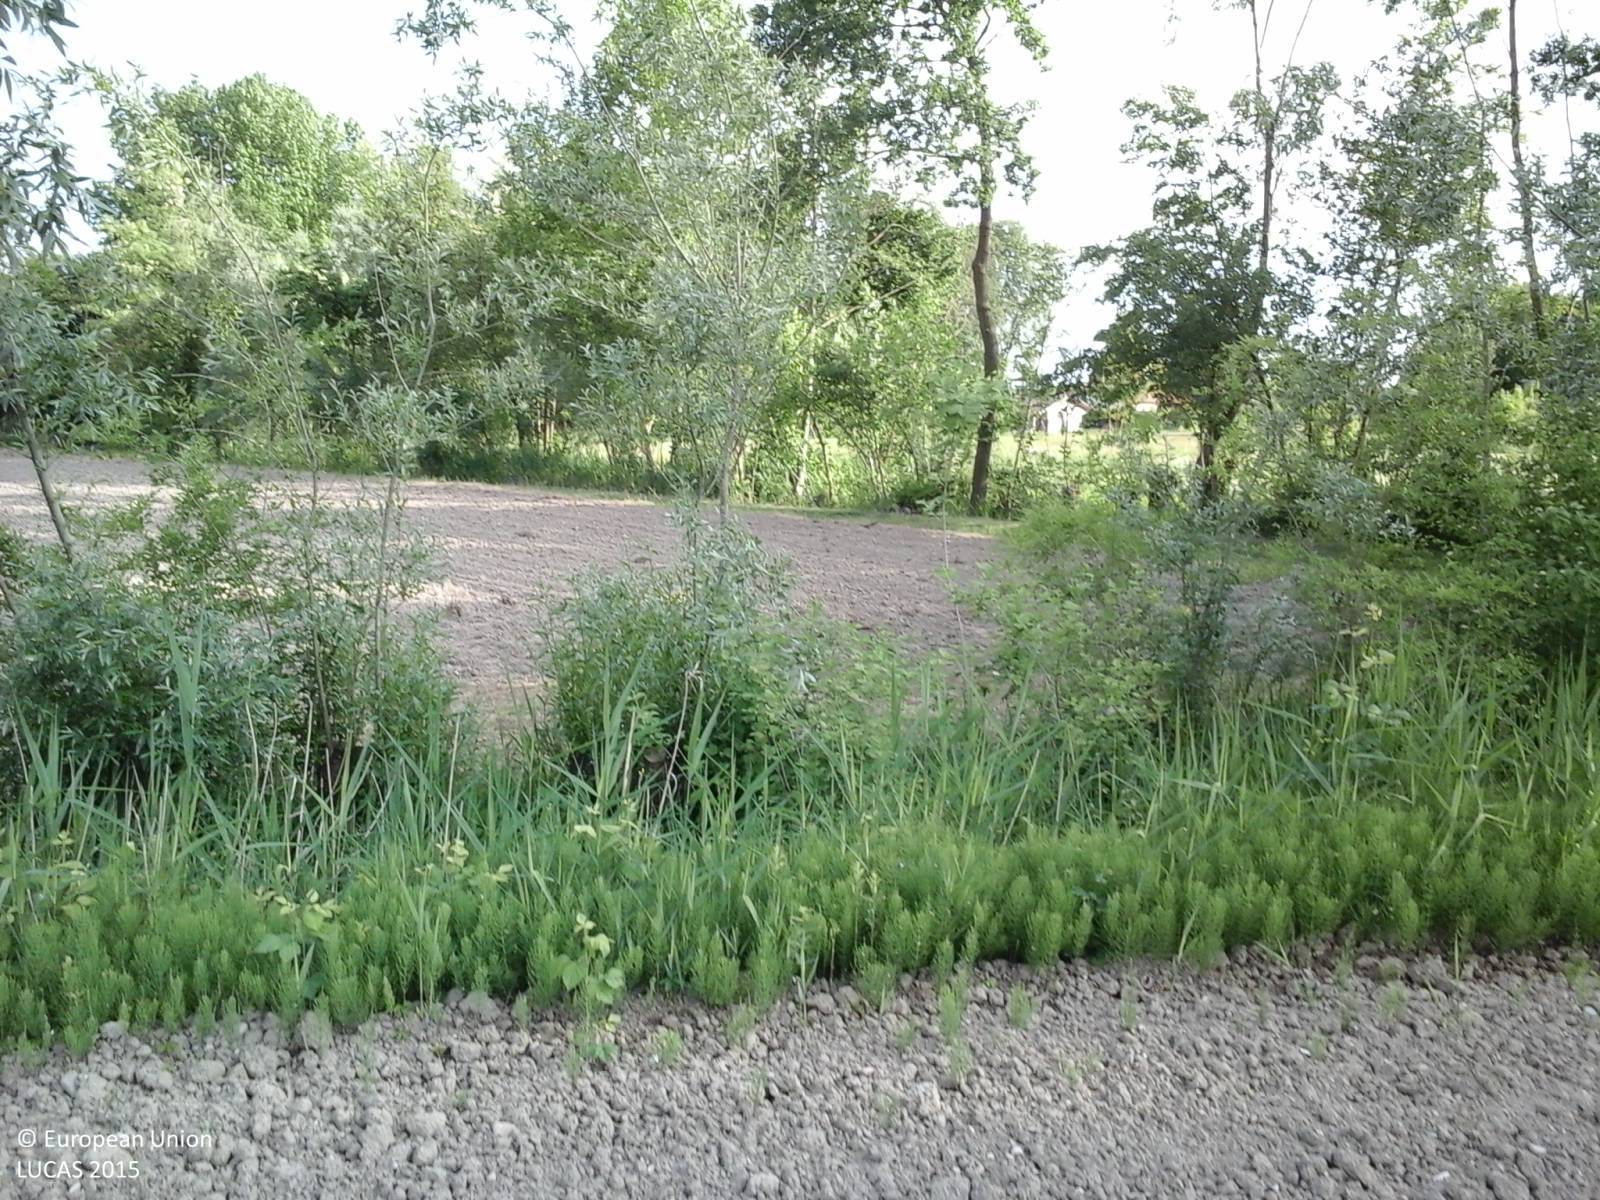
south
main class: Cropland
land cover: Soya
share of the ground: < 10 %
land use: Agriculture (excluding fallow land and kitchen gardens)
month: May
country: IT
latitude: 45.8751
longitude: 13.0496
